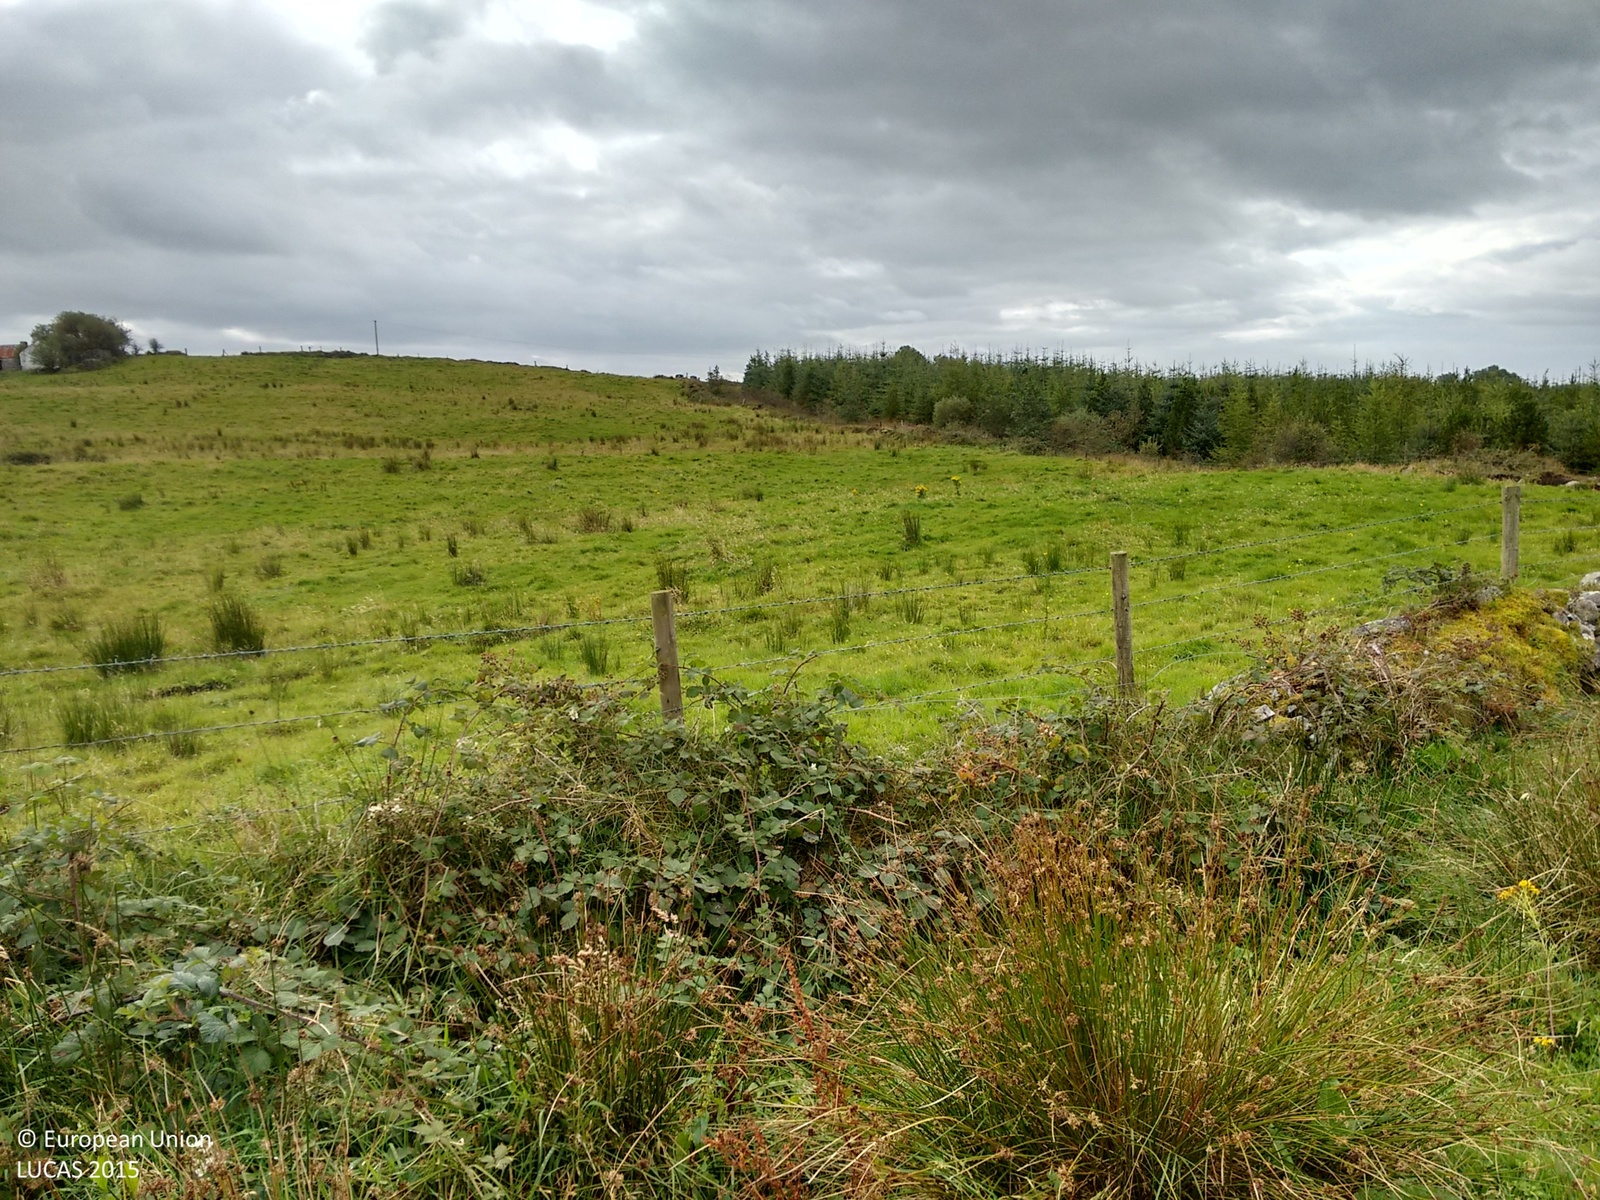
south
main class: Grassland
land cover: Grassland without tree/shrub cover
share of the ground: > 75 %
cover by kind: herbaceous plants 100 %
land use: Agriculture (excluding fallow land and kitchen gardens)
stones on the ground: < 10 %
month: September
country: IE
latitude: 53.8997
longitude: -8.8492
